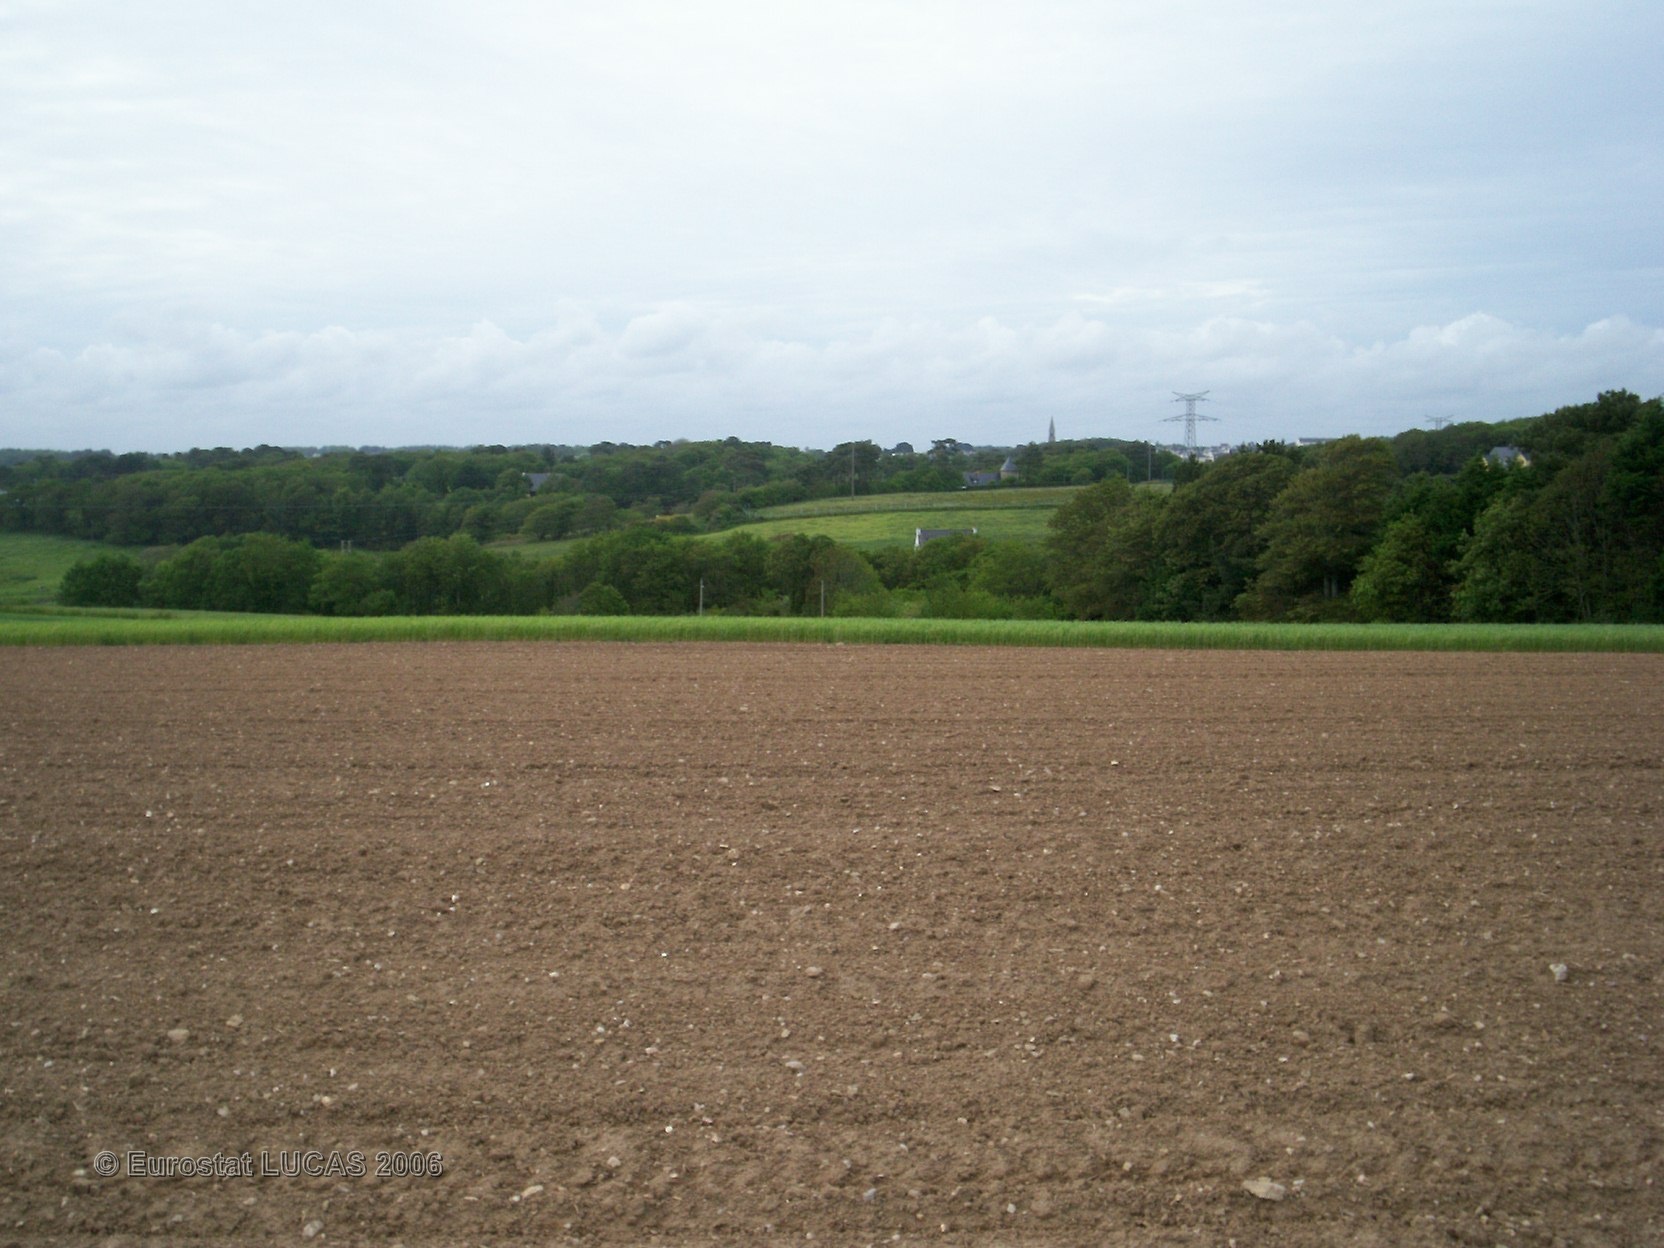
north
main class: Cropland
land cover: Maize
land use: Agriculture (excluding fallow land and kitchen gardens)
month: May
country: FR
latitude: 47.7732
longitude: -3.4862
